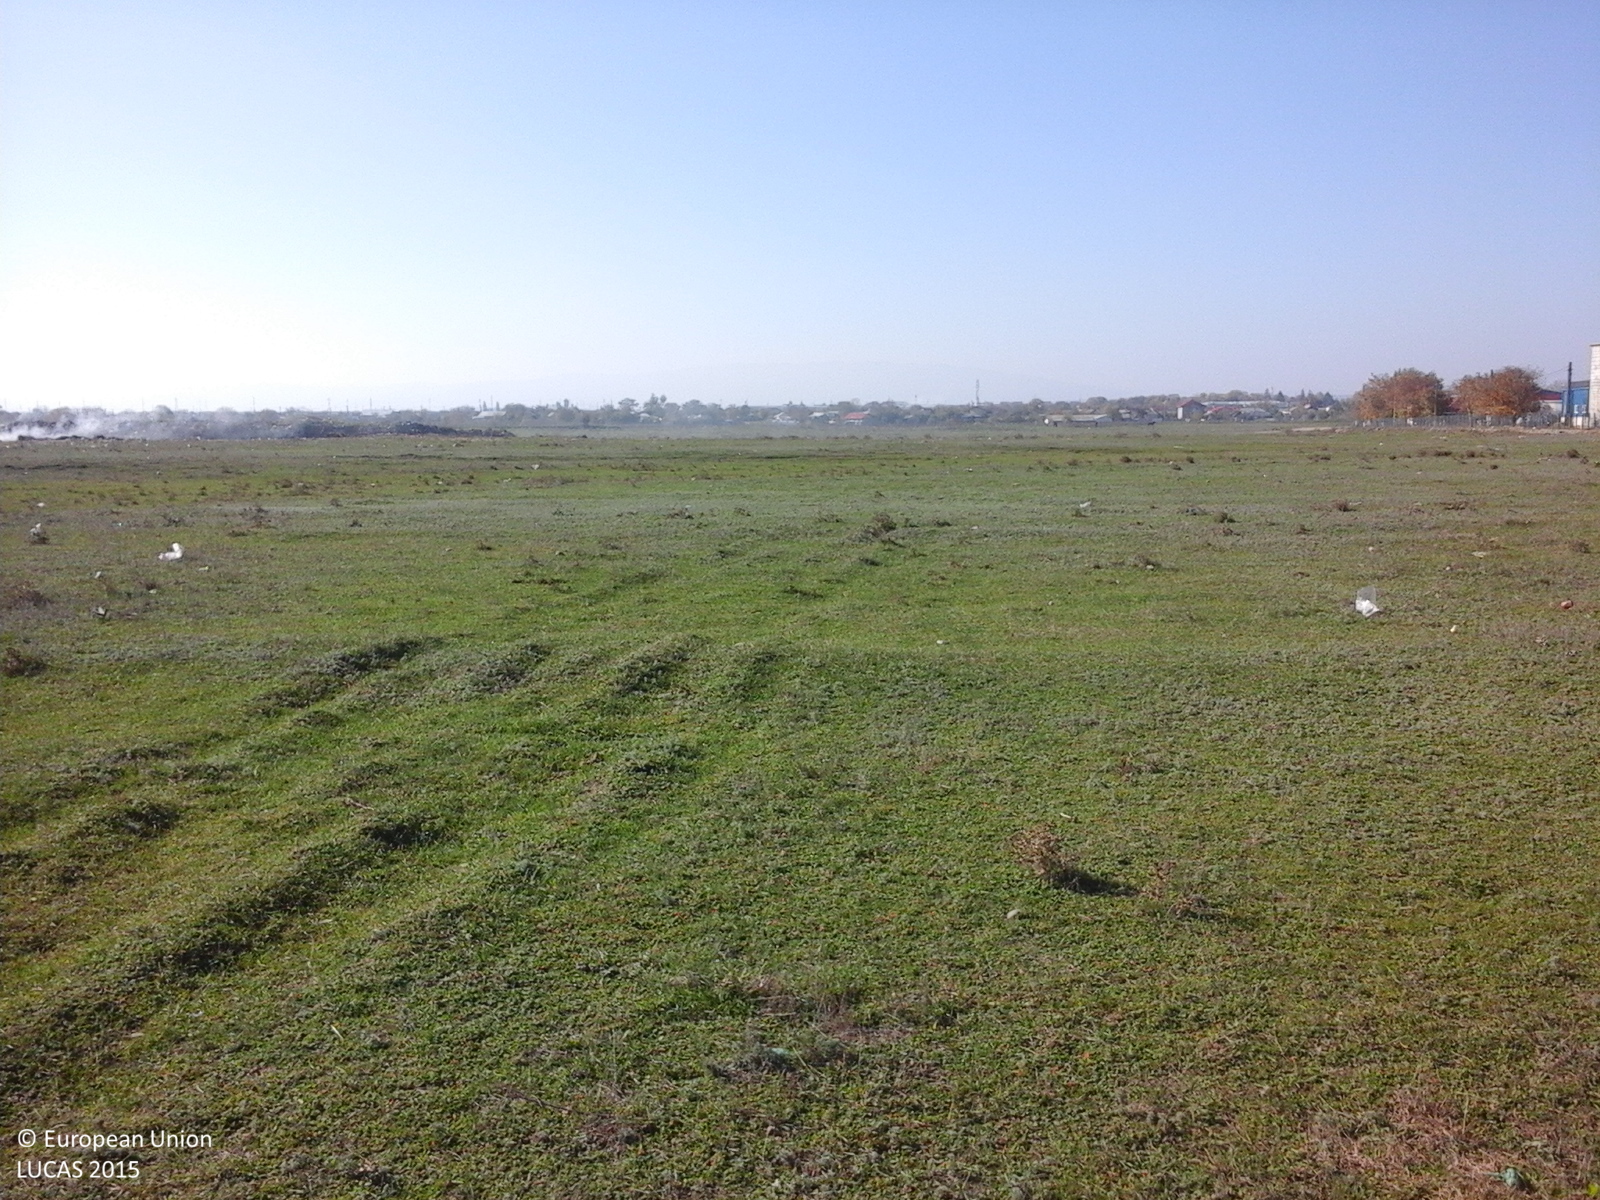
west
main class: Grassland
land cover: Grassland without tree/shrub cover
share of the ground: > 75 %
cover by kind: herbaceous plants 100 %
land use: Agriculture (excluding fallow land and kitchen gardens)
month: October
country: RO
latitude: 45.8752
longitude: 27.2460
